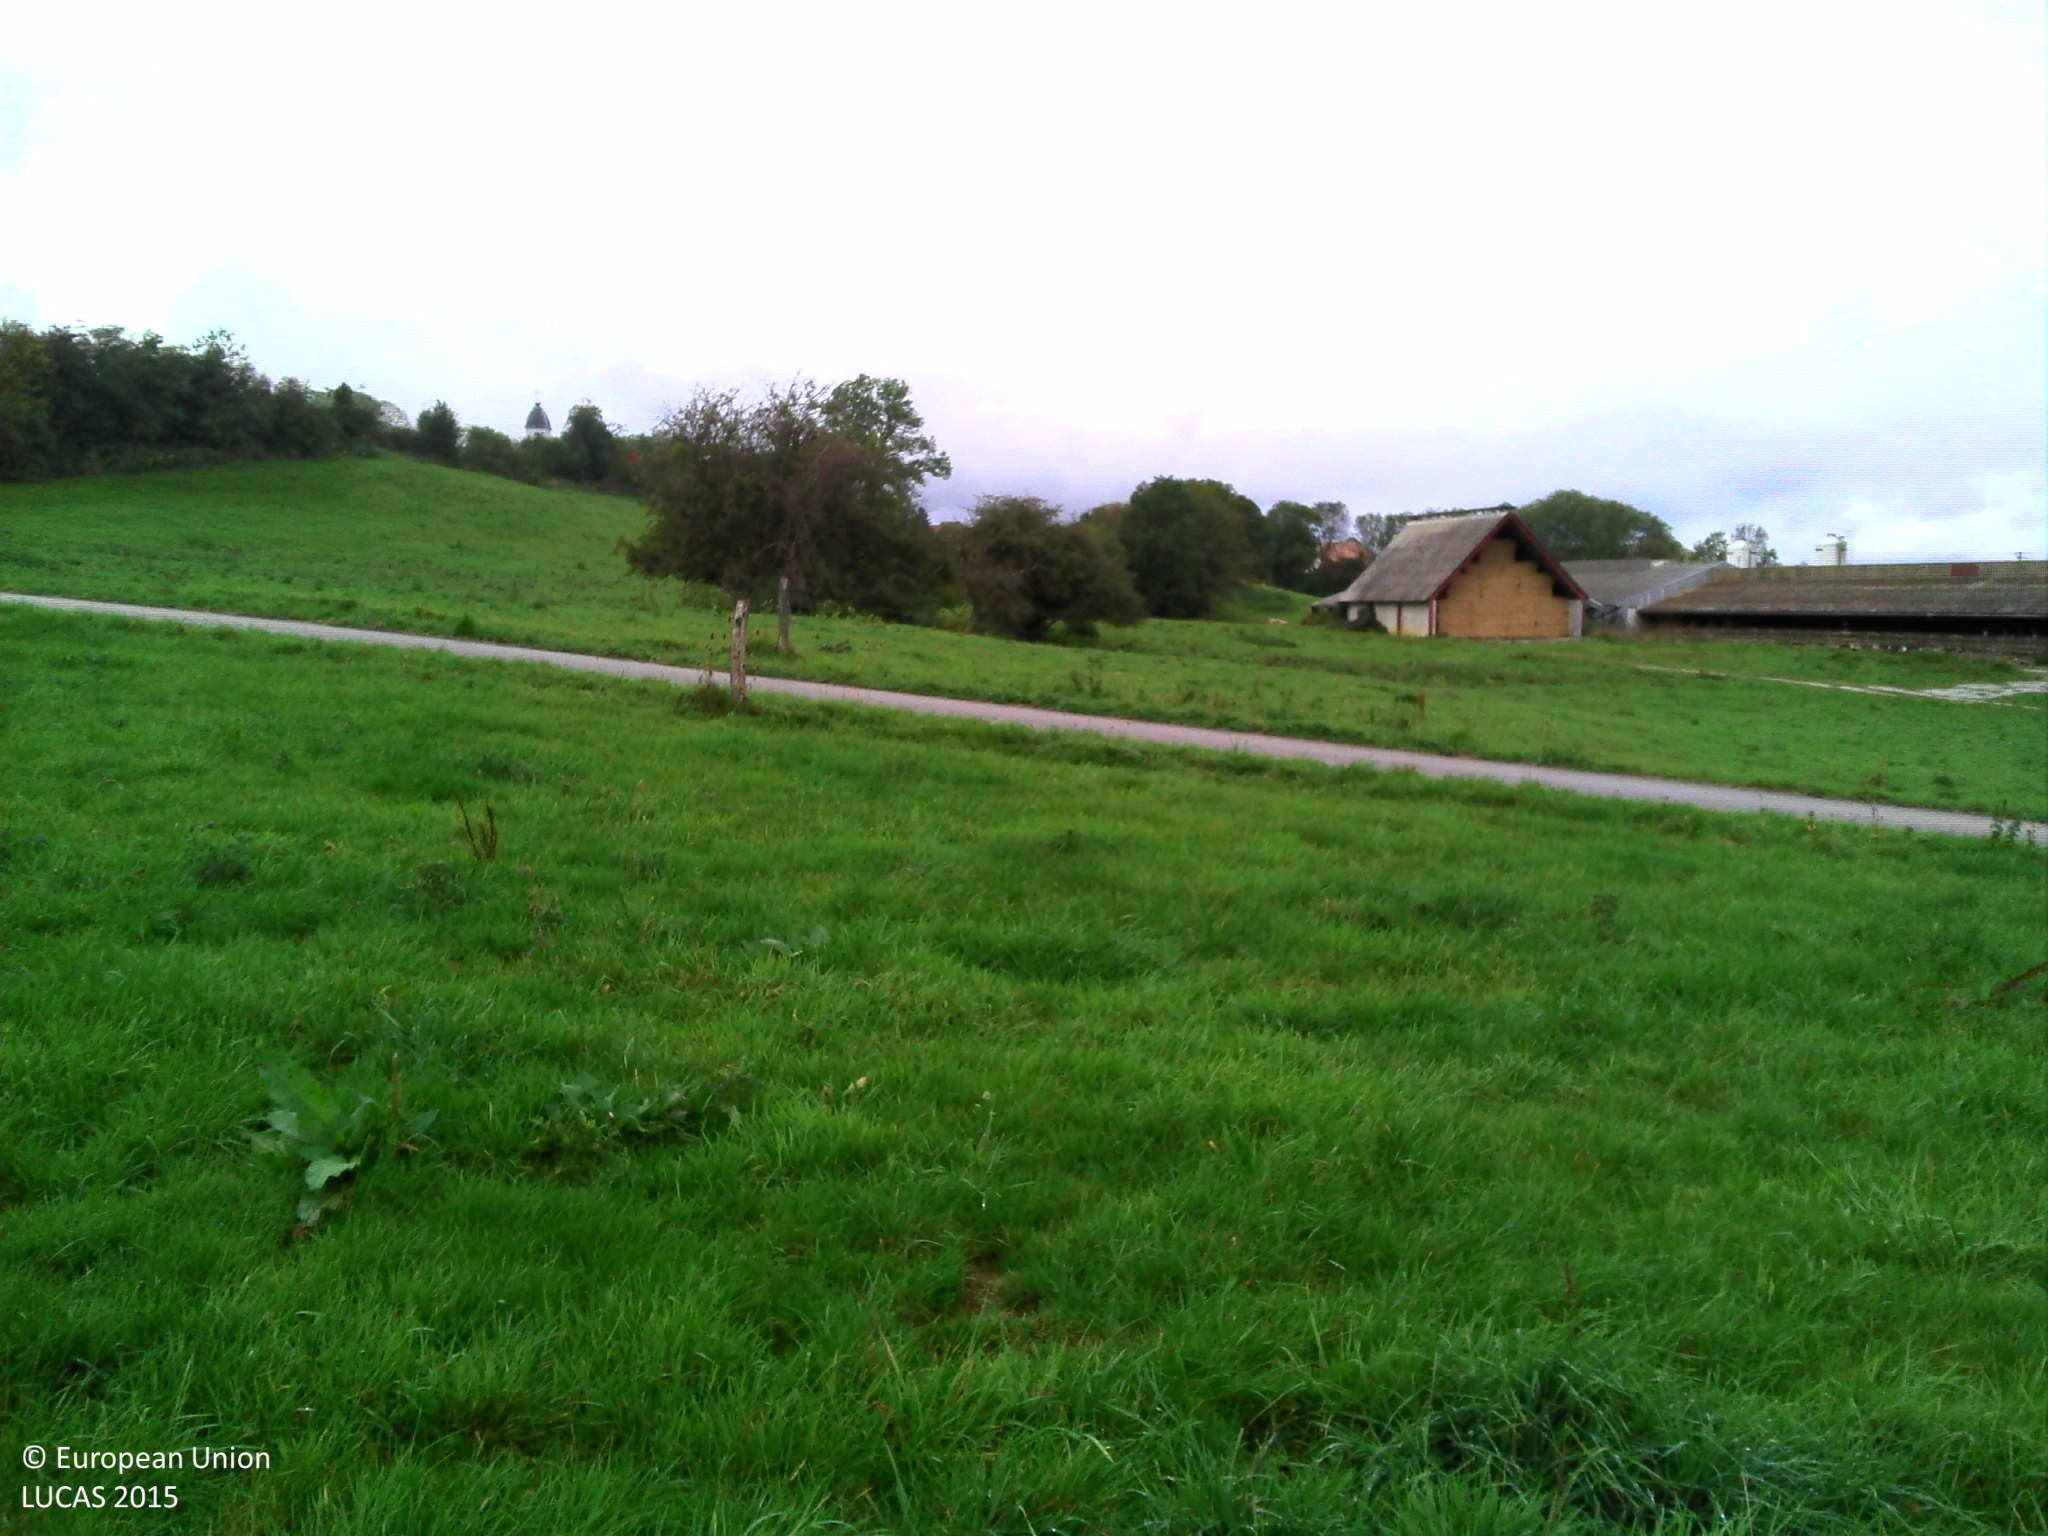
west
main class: Grassland
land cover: Grassland without tree/shrub cover
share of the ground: > 75 %
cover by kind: herbaceous plants 100 %
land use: Agriculture (excluding fallow land and kitchen gardens)
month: October
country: FR
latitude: 47.0201
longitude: 6.1211
